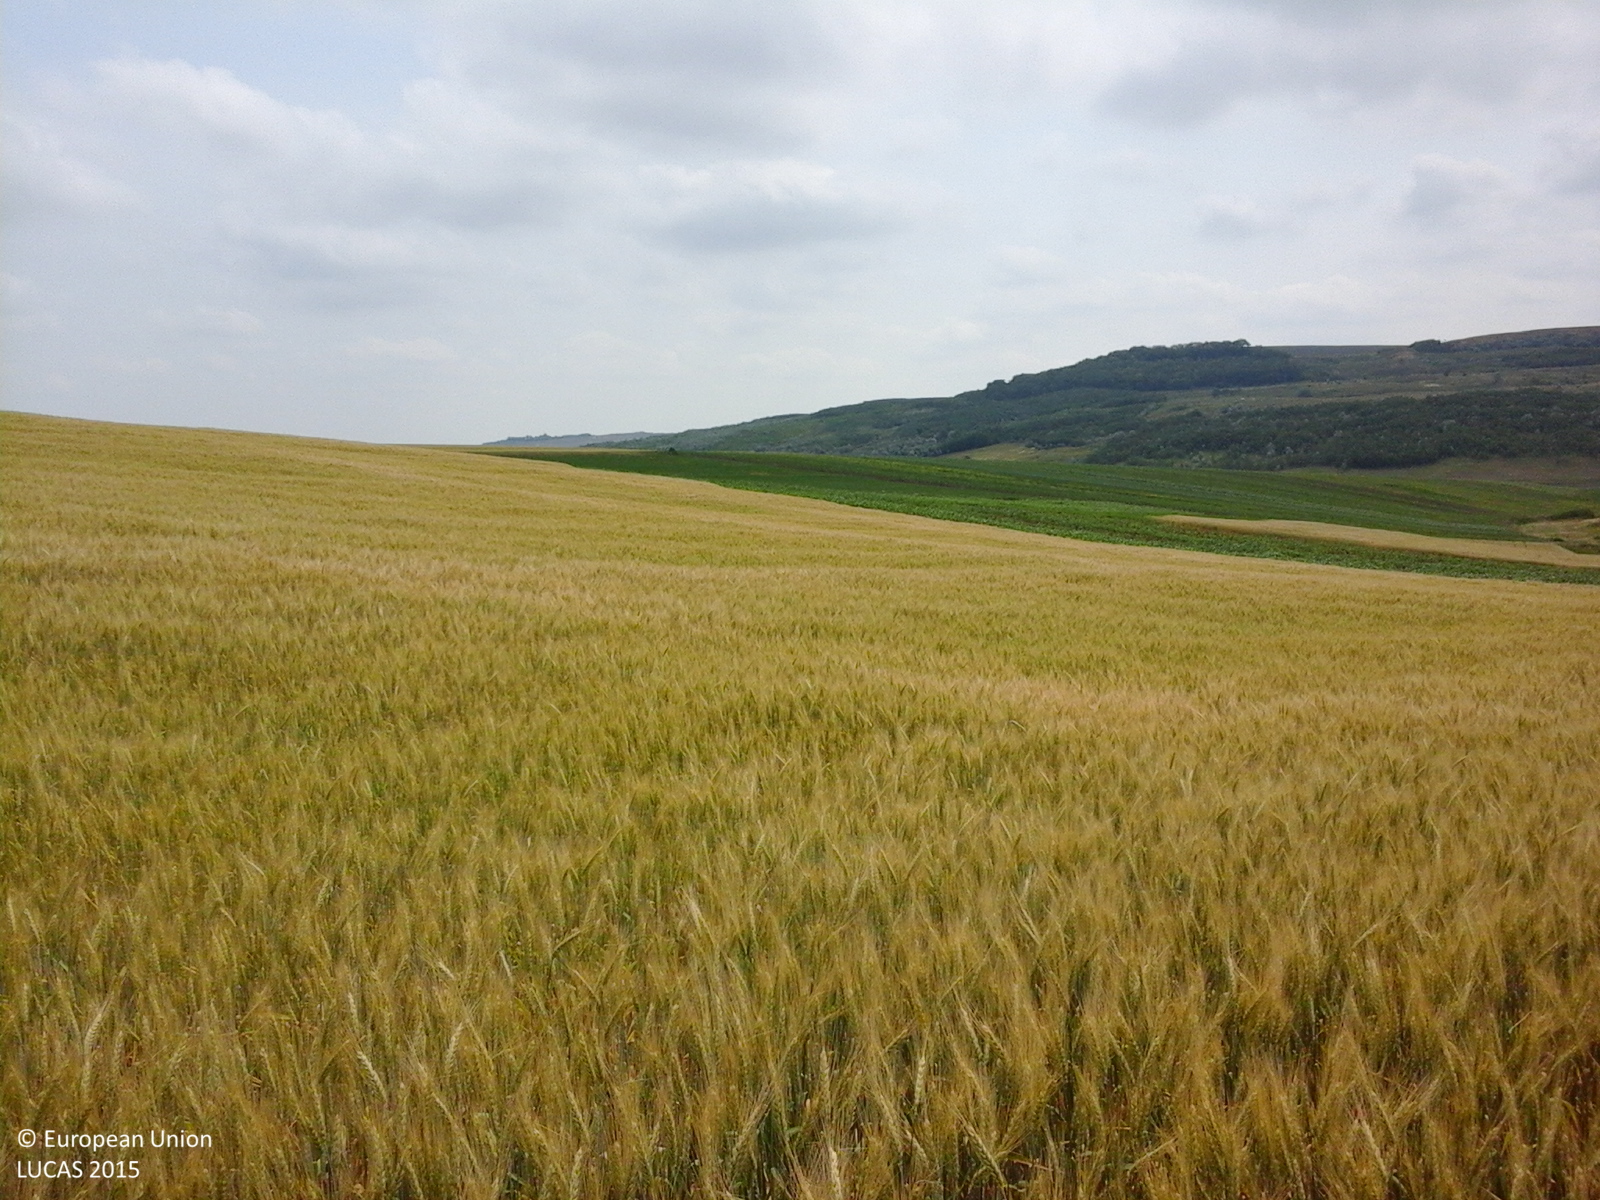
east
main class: Cropland
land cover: Common wheat
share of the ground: > 75 %
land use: Agriculture (excluding fallow land and kitchen gardens)
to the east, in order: Common wheat; Maize; Lucerne
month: June
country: RO
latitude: 47.9837
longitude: 26.5878
